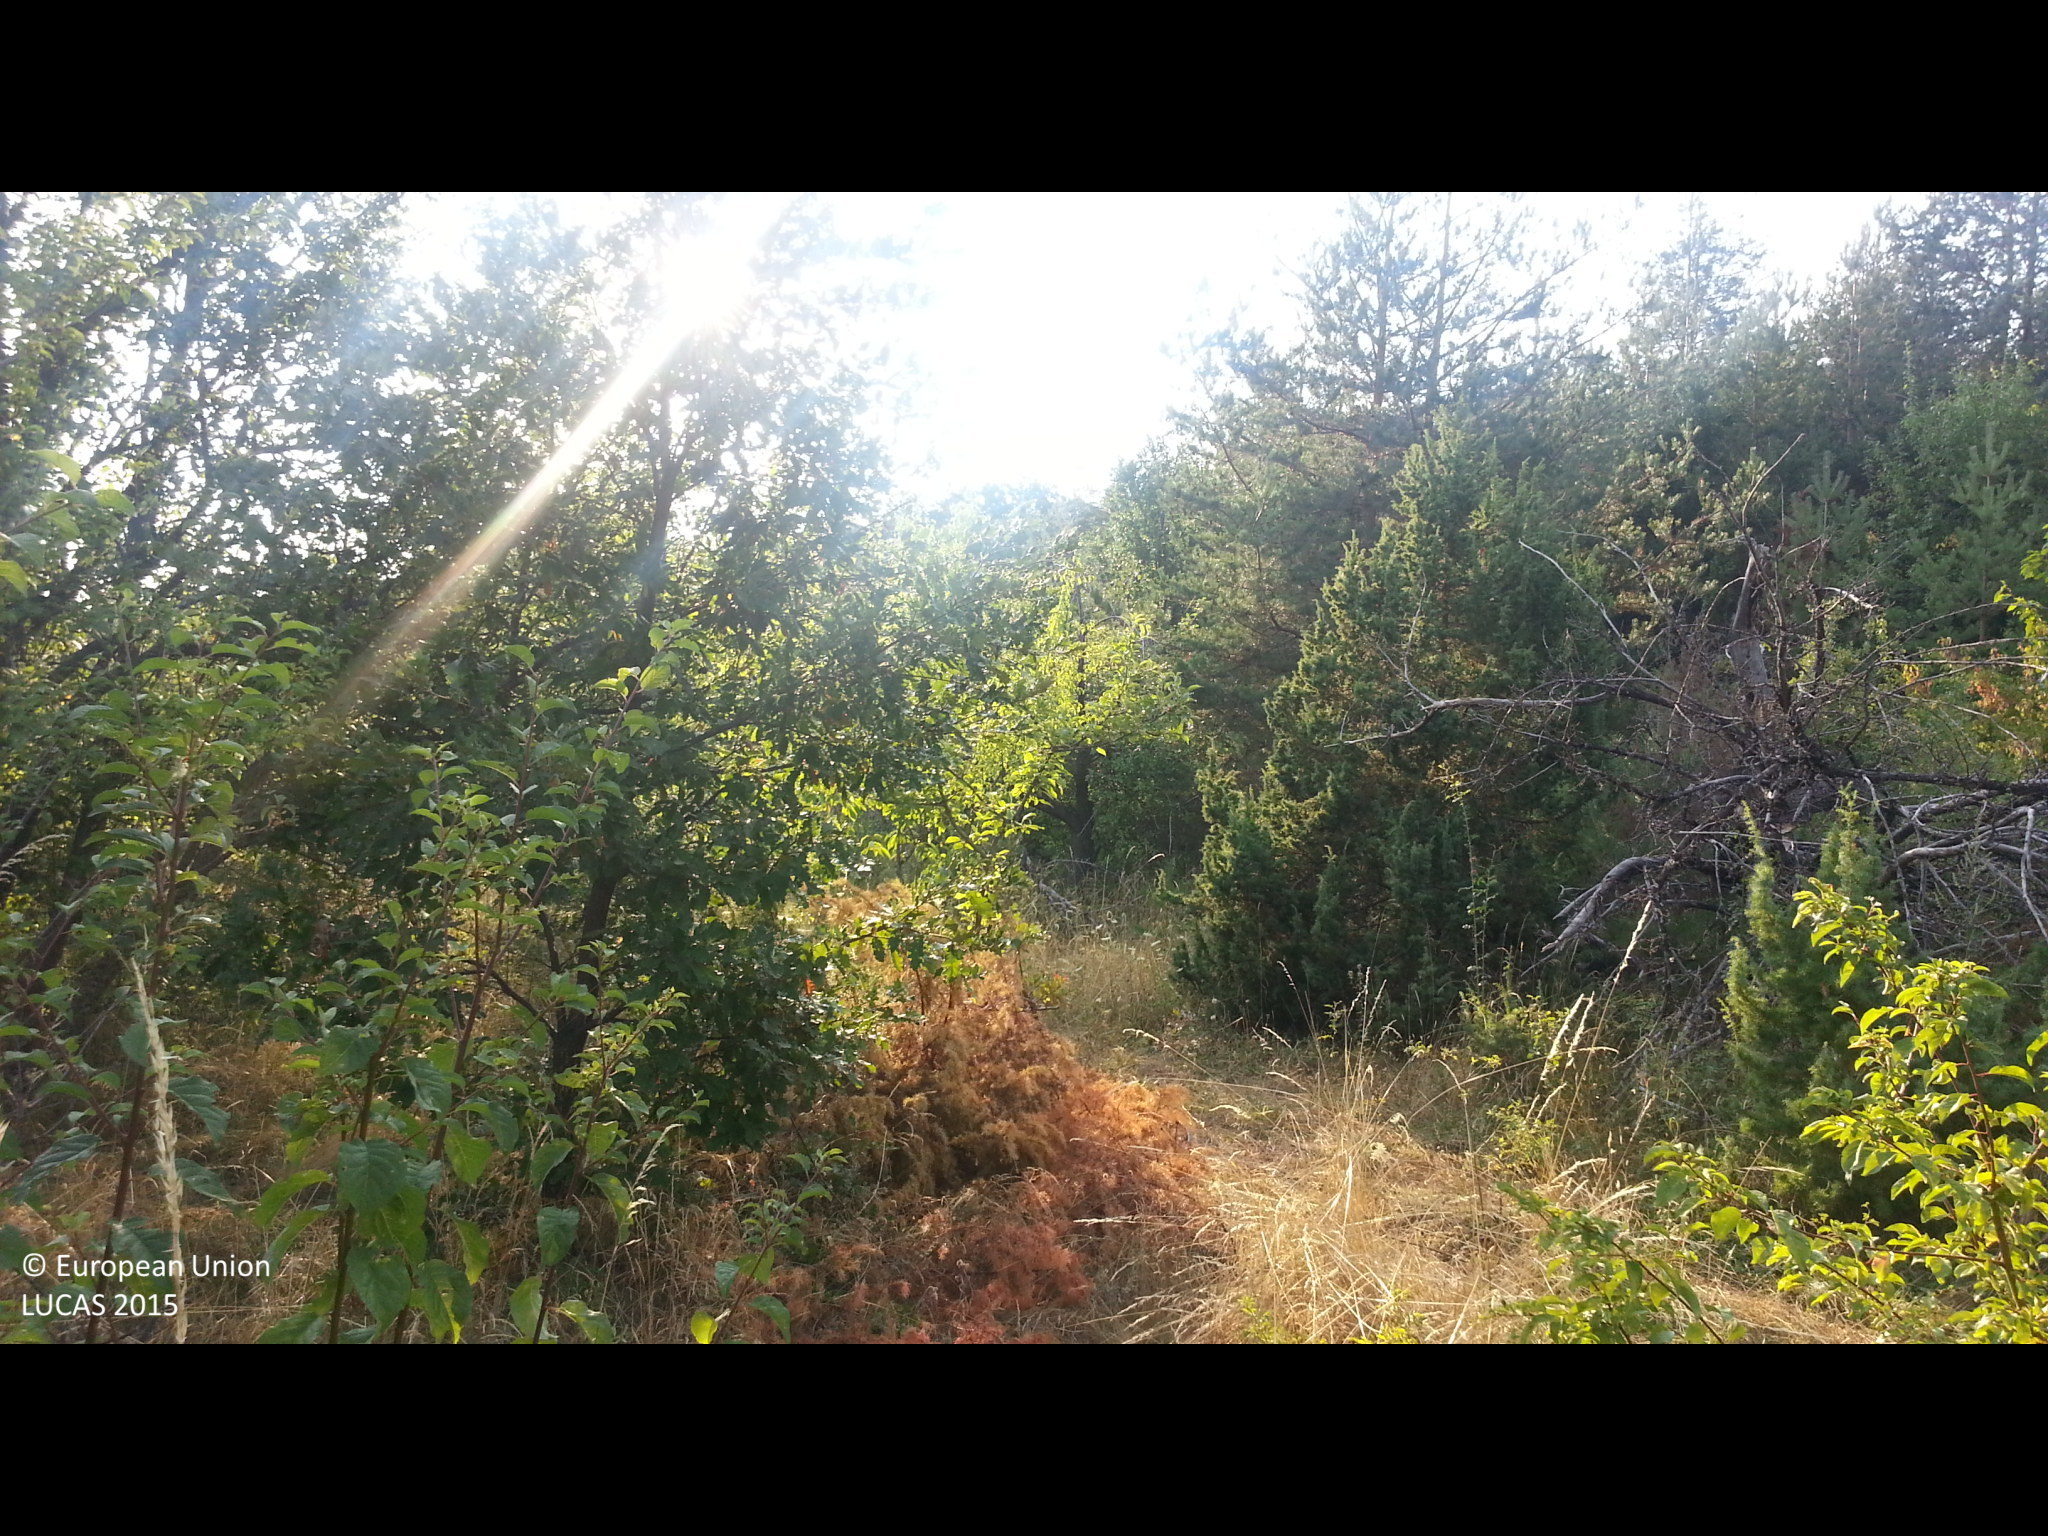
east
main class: Cropland
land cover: Cherry fruit
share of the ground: > 75 %
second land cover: Spontaneously vegetated surfaces
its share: > 75 %
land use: Agriculture (excluding fallow land and kitchen gardens)
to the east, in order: Cherry fruit; Spontaneously vegetated surfaces; Broadleaved woodland; Ditches and canals; Grassland with sparse tree/shrub cover; Shrubland with sparse tree cover; Paved roads, cycling and walking lanes; Grassland without tree/shrub cover; Cherry fruit; Grassland without tree/shrub cover; Fences; Cherry fruit; Electric lines; Tracks; Grassland with sparse tree/shrub cover; Cherry fruit
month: August
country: BG
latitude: 42.4025
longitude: 22.6704
